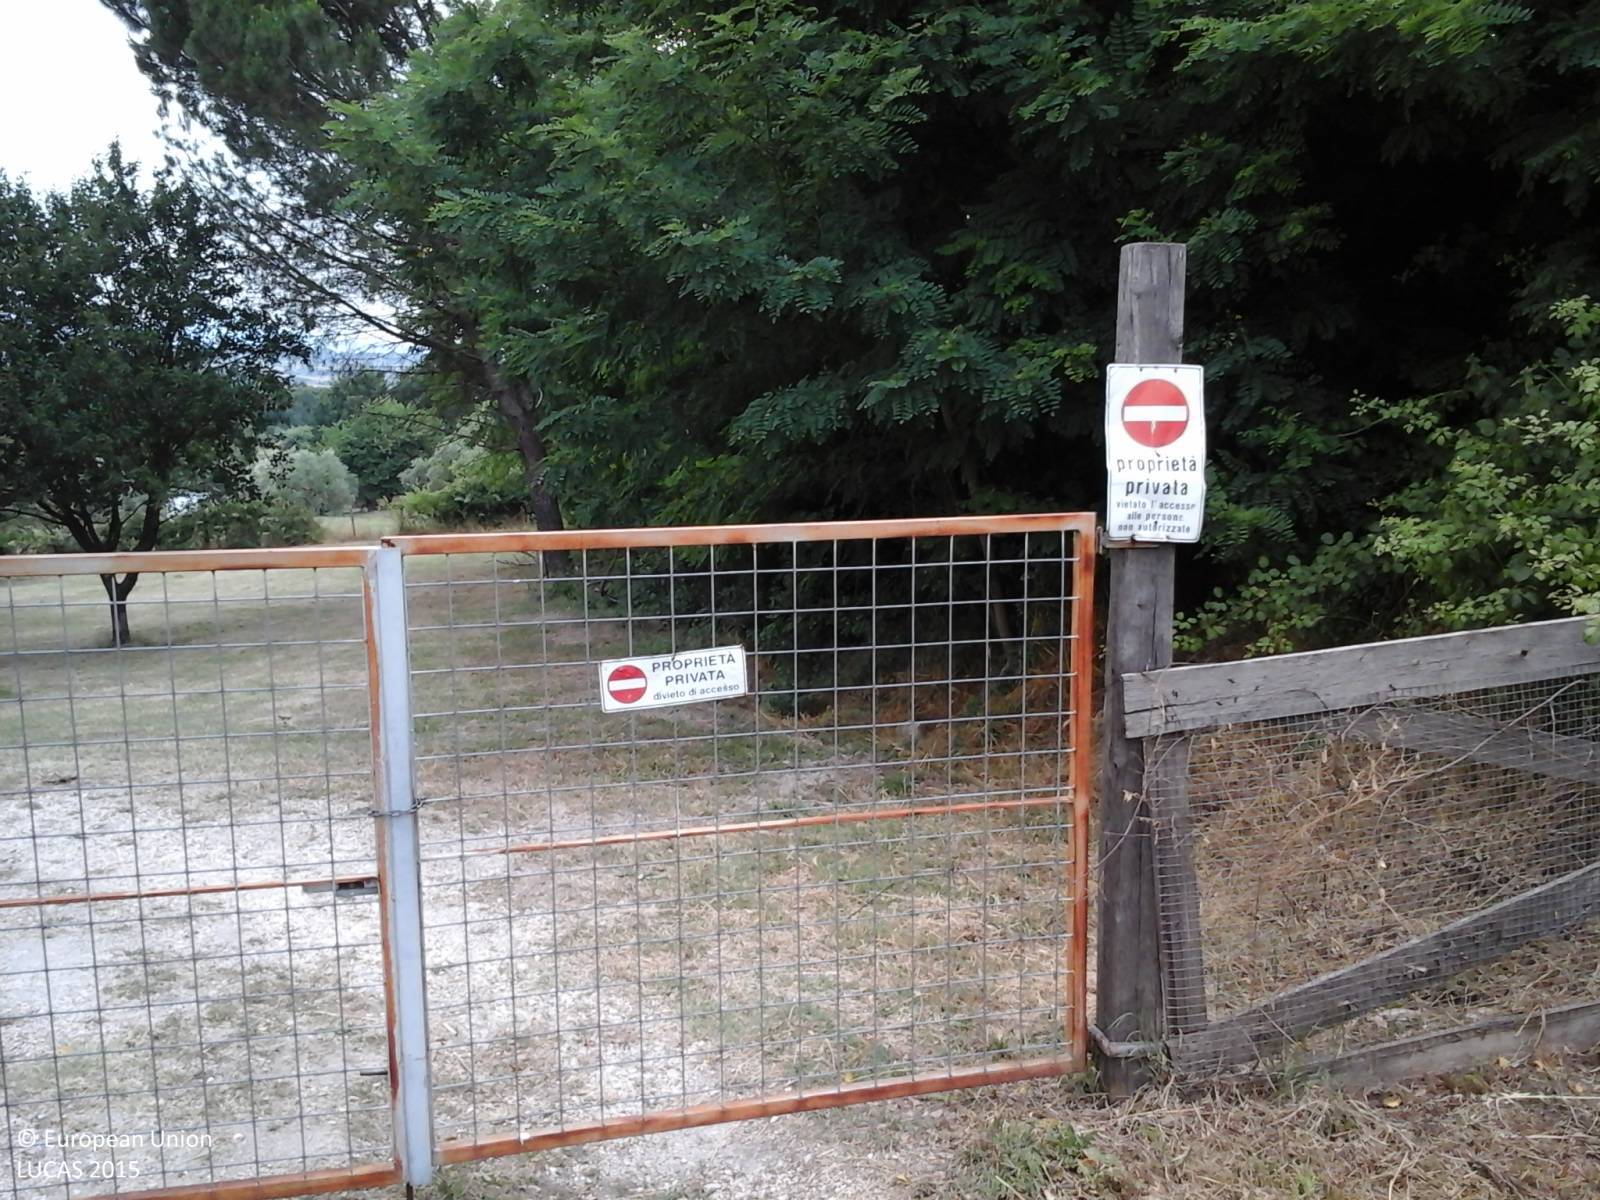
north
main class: Woodland
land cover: Broadleaved woodland
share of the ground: 50 - 75 %
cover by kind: herbaceous plants 60 %, broadleaved forest trees 15 %, unconsolidated bare surface 15 %, coniferous forest trees 5 %, shrubs 5 %
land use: Residential
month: June
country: IT
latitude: 42.1388
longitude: 12.3509
